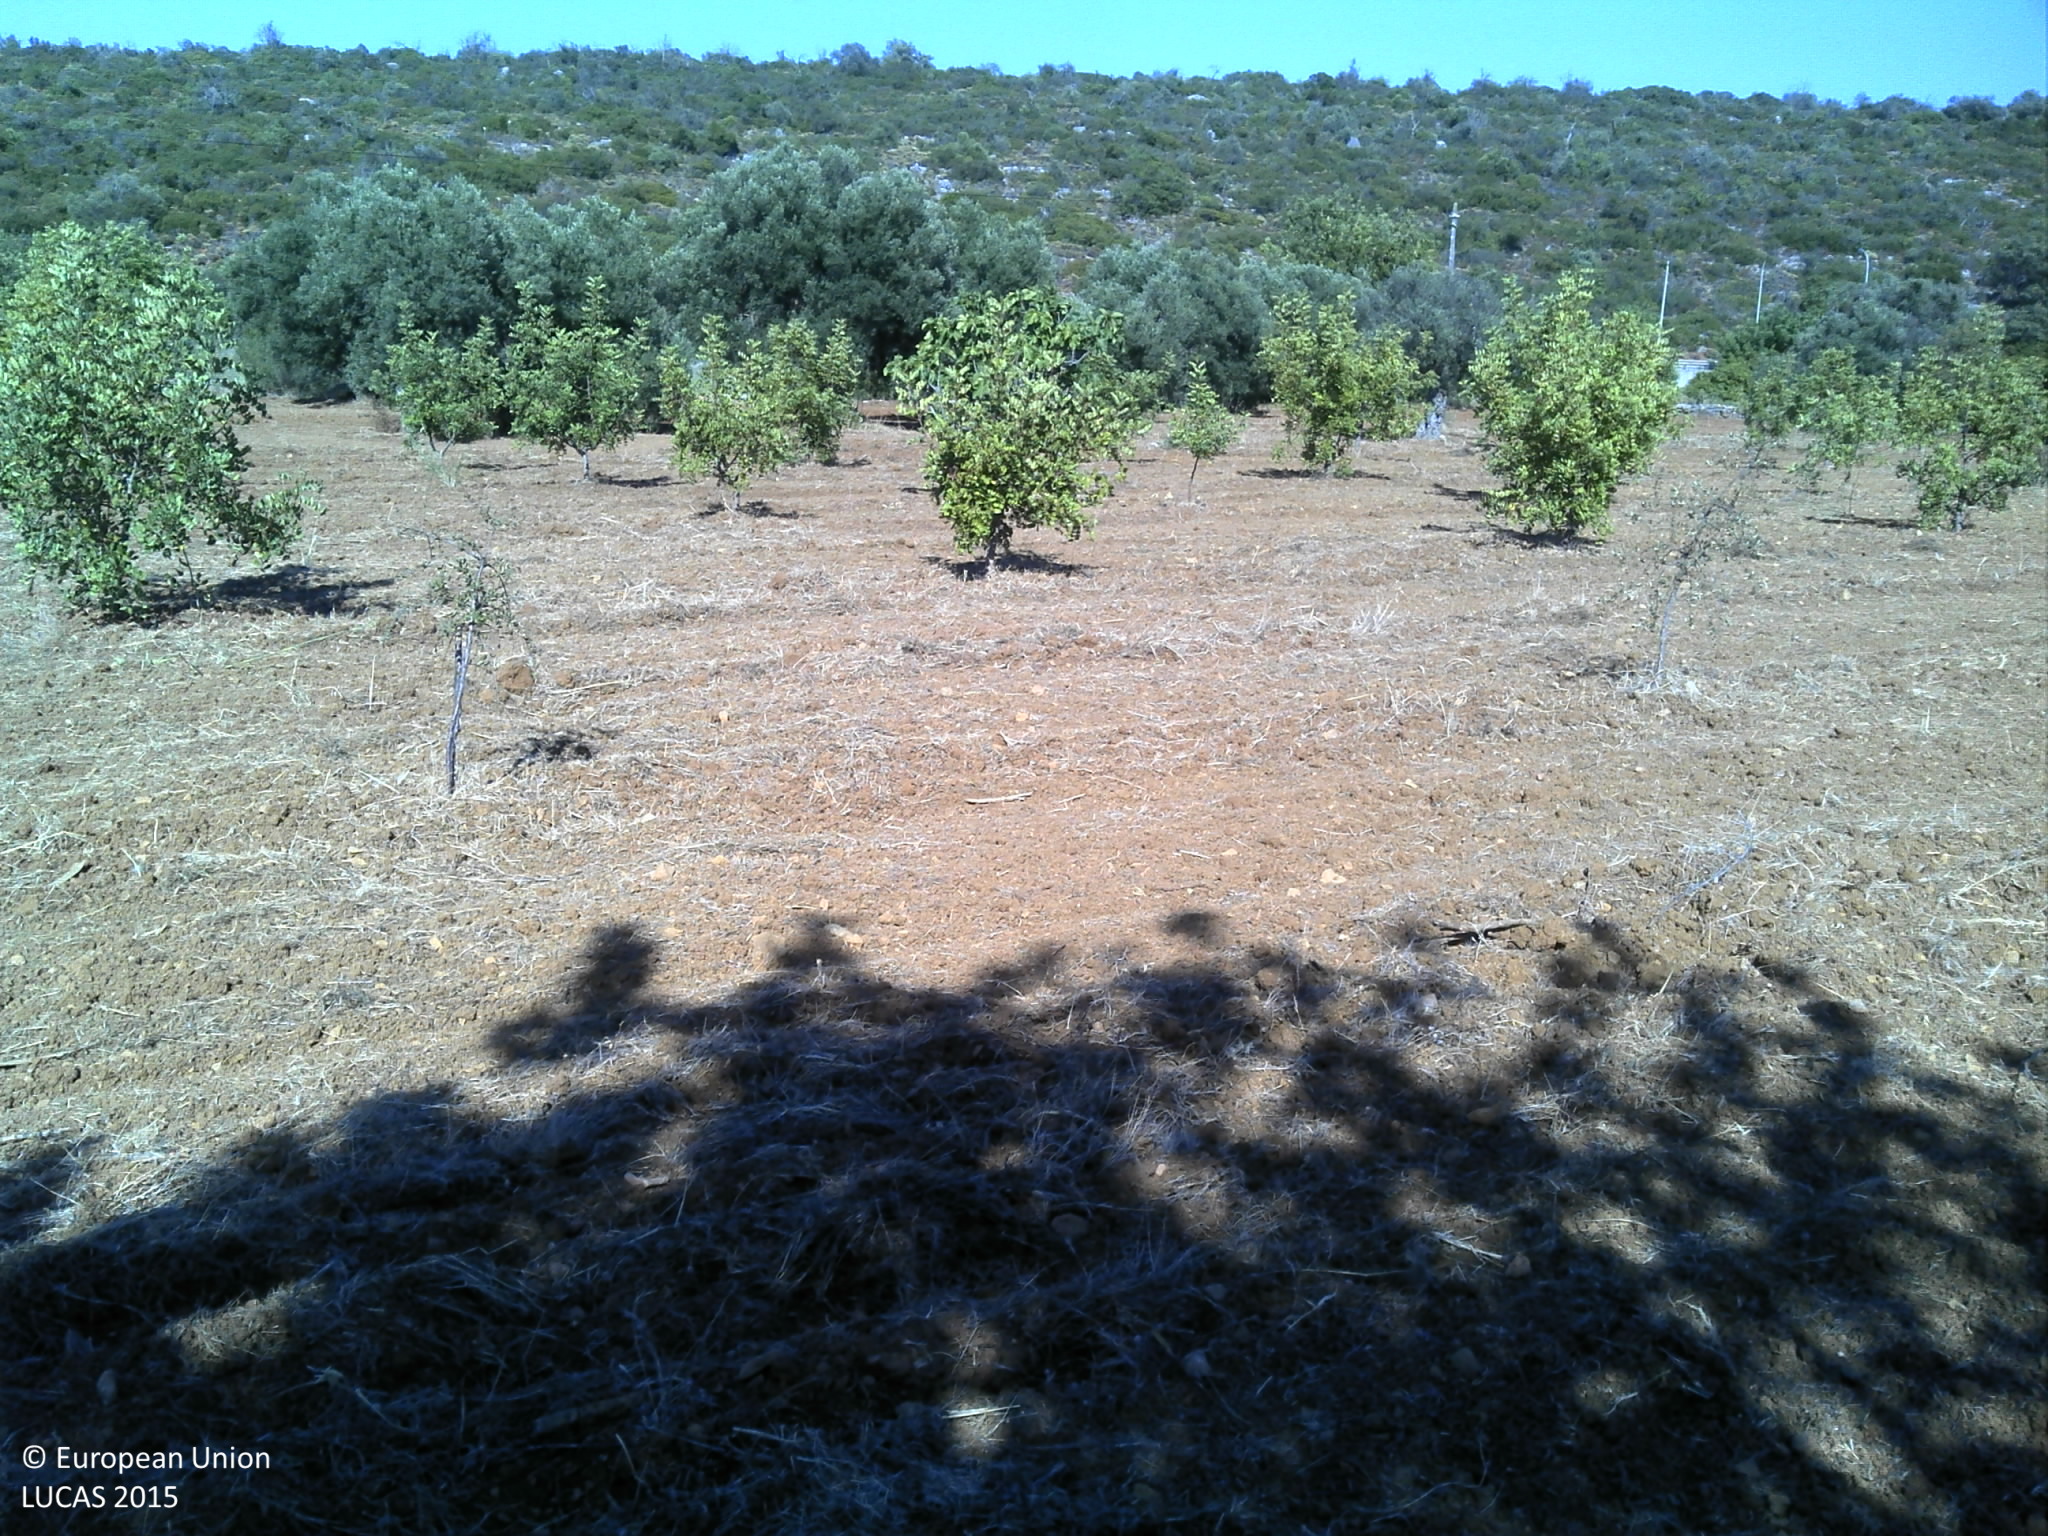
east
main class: Cropland
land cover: Permanent industrial crops
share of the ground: 10 - 25 %
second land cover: Other bare soil
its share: > 75 %
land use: Agriculture (excluding fallow land and kitchen gardens)
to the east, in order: Permanent industrial crops; Other bare soil; Permanent industrial crops; Olive groves; Electric lines; Olive groves; Dry stone walls; Ditches and canals; Tracks; Dry stone walls; Grassland without tree/shrub cover; Dry stone walls; Ditches and canals; Shrubland with sparse tree cover; Paved roads, cycling and walking lanes; Electric lines; Shrubland without tree cover; Paved roads, cycling and walking lanes; Shrubland with sparse tree cover; Rock outcrops; Shrubland with sparse tree cover
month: June
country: PT
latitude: 37.1088
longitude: -7.7987
